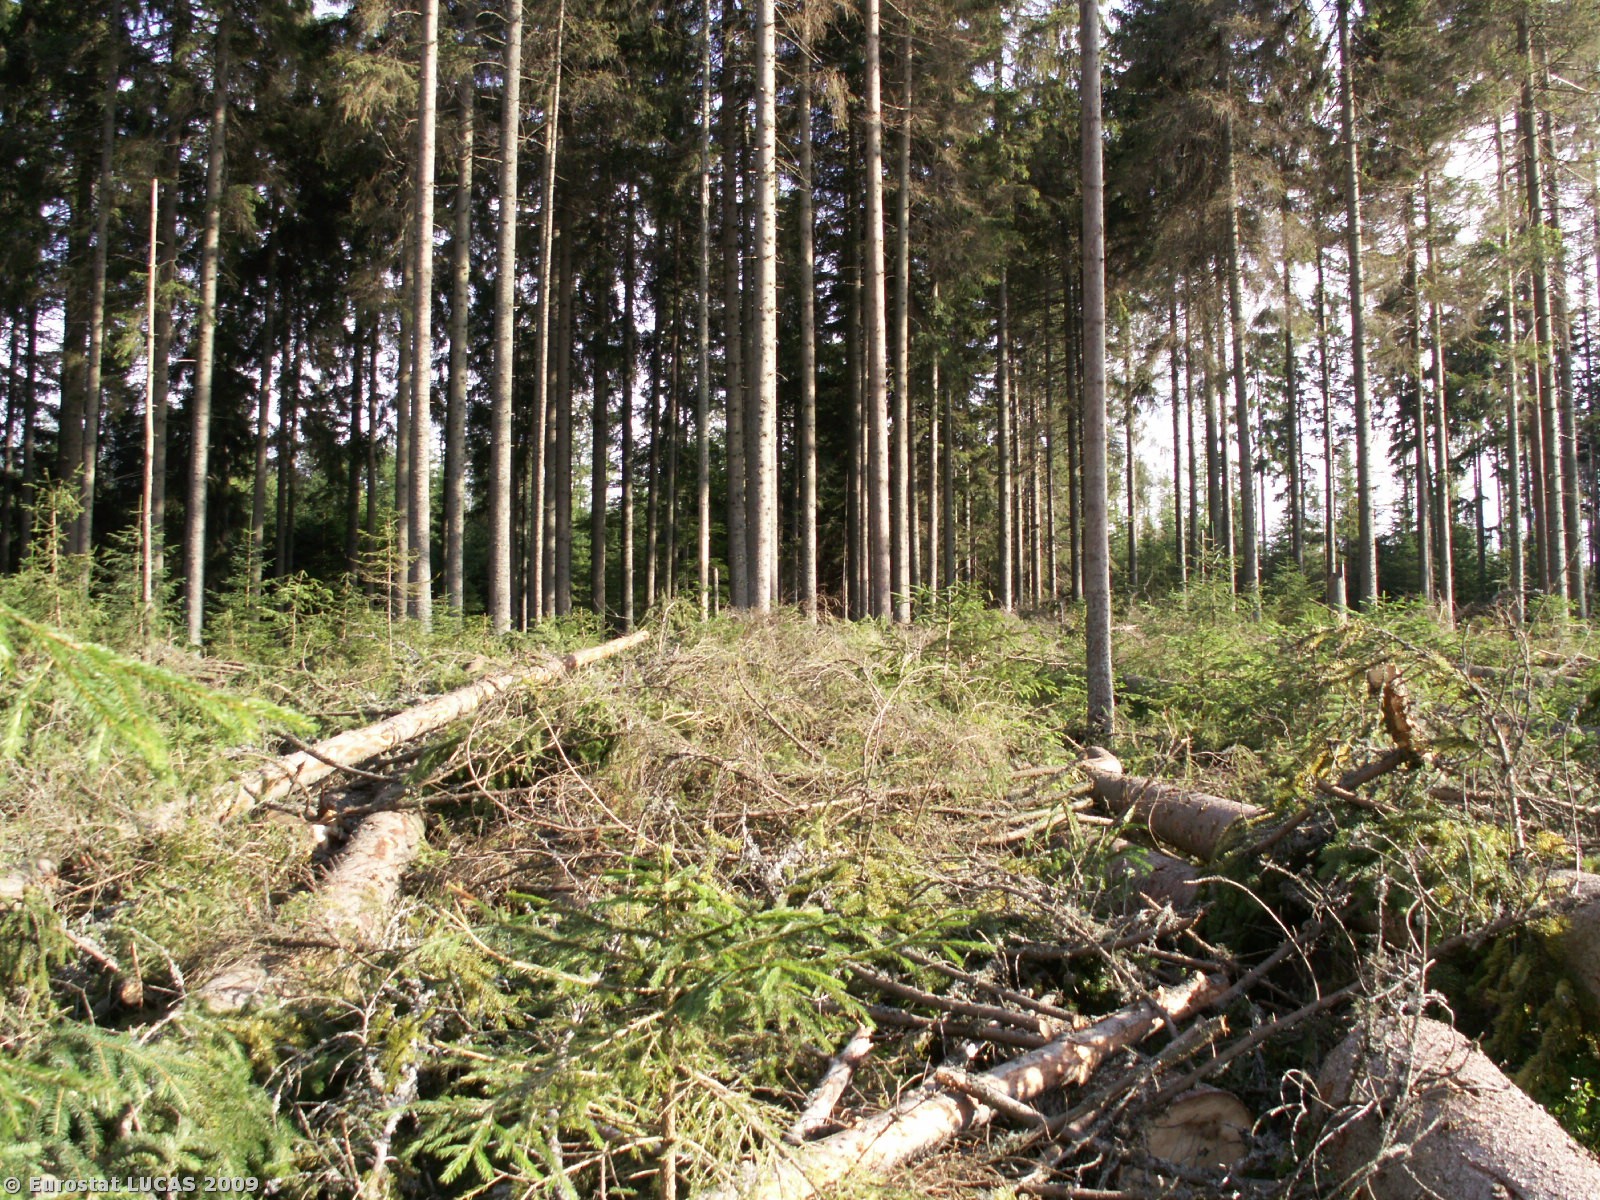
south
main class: Woodland
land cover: Coniferous woodland
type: hemiboreal forest and nemoral coniferous forest and mixed broadleaved-coniferous forest
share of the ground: > 75 %
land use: Forestry
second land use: Nature reserves
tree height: > 5 m
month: July
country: CZ
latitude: 48.8056
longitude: 13.8261
